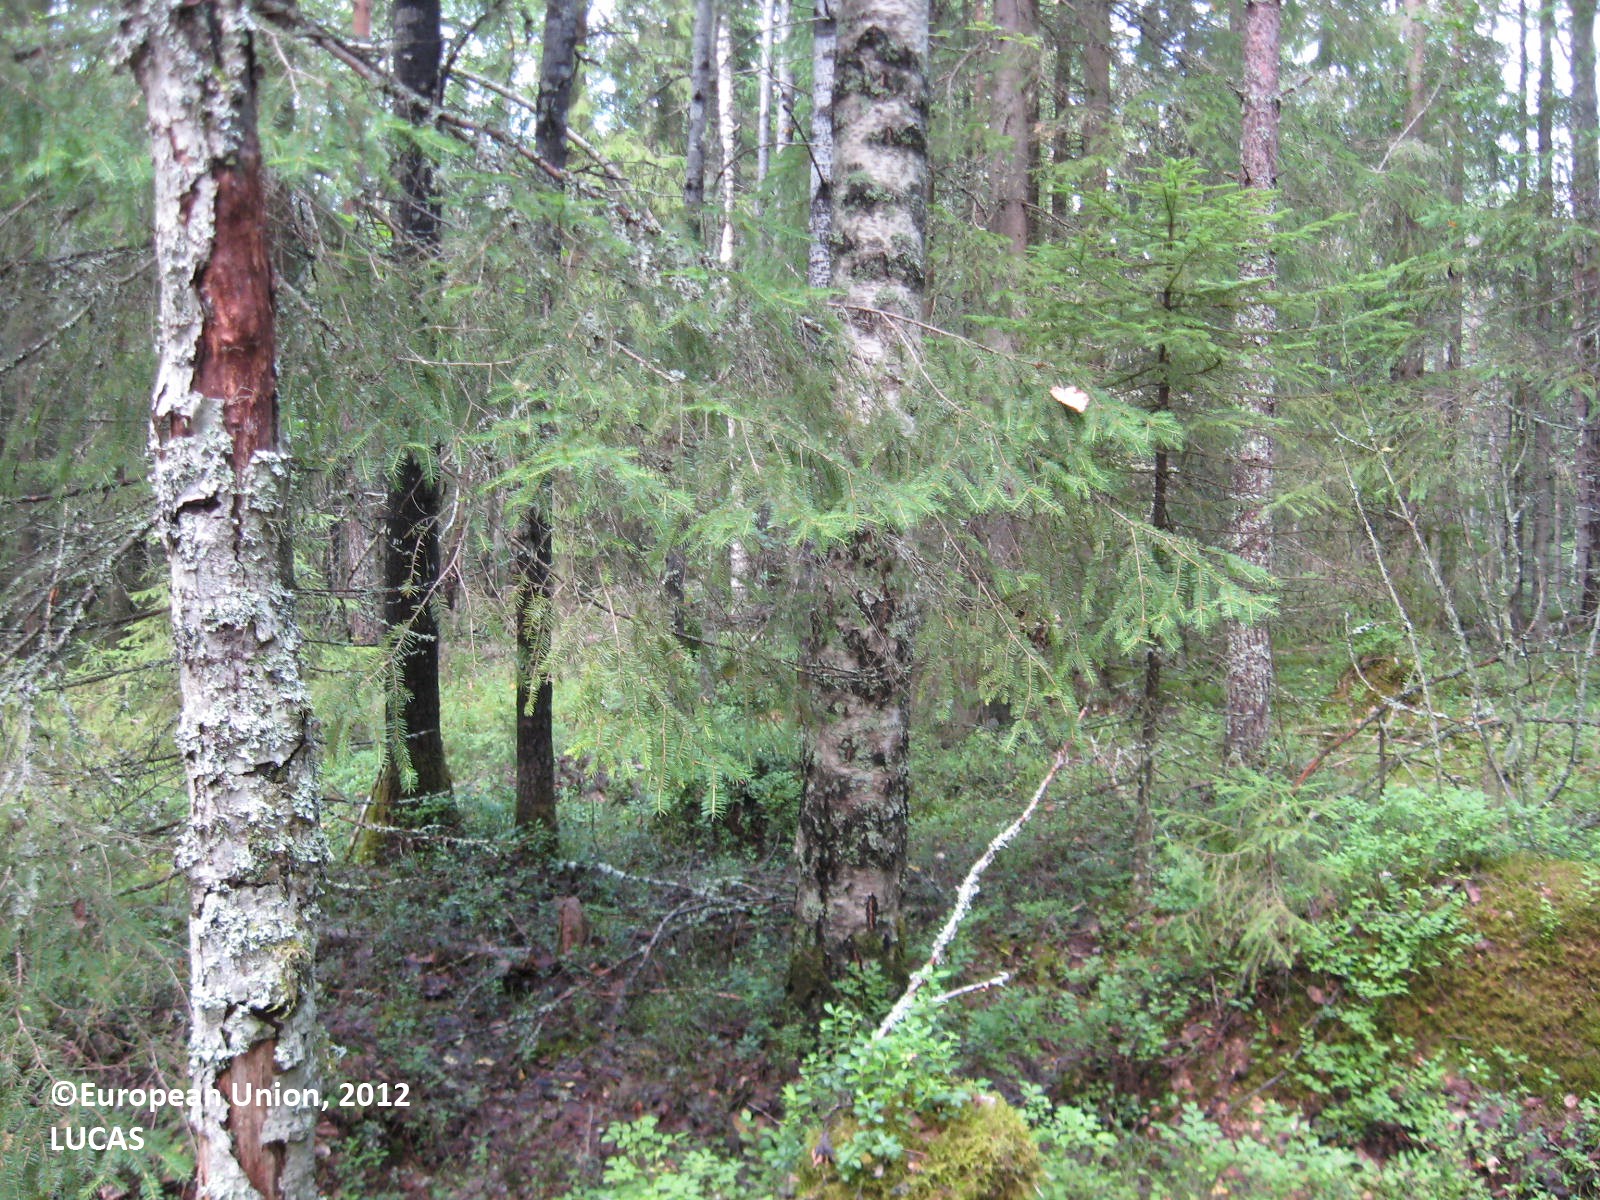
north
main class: Woodland
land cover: Other mixed woodland
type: boreal forest
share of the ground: > 75 %
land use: Forestry
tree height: > 5 m
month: July
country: FI
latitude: 62.0291
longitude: 22.7729
